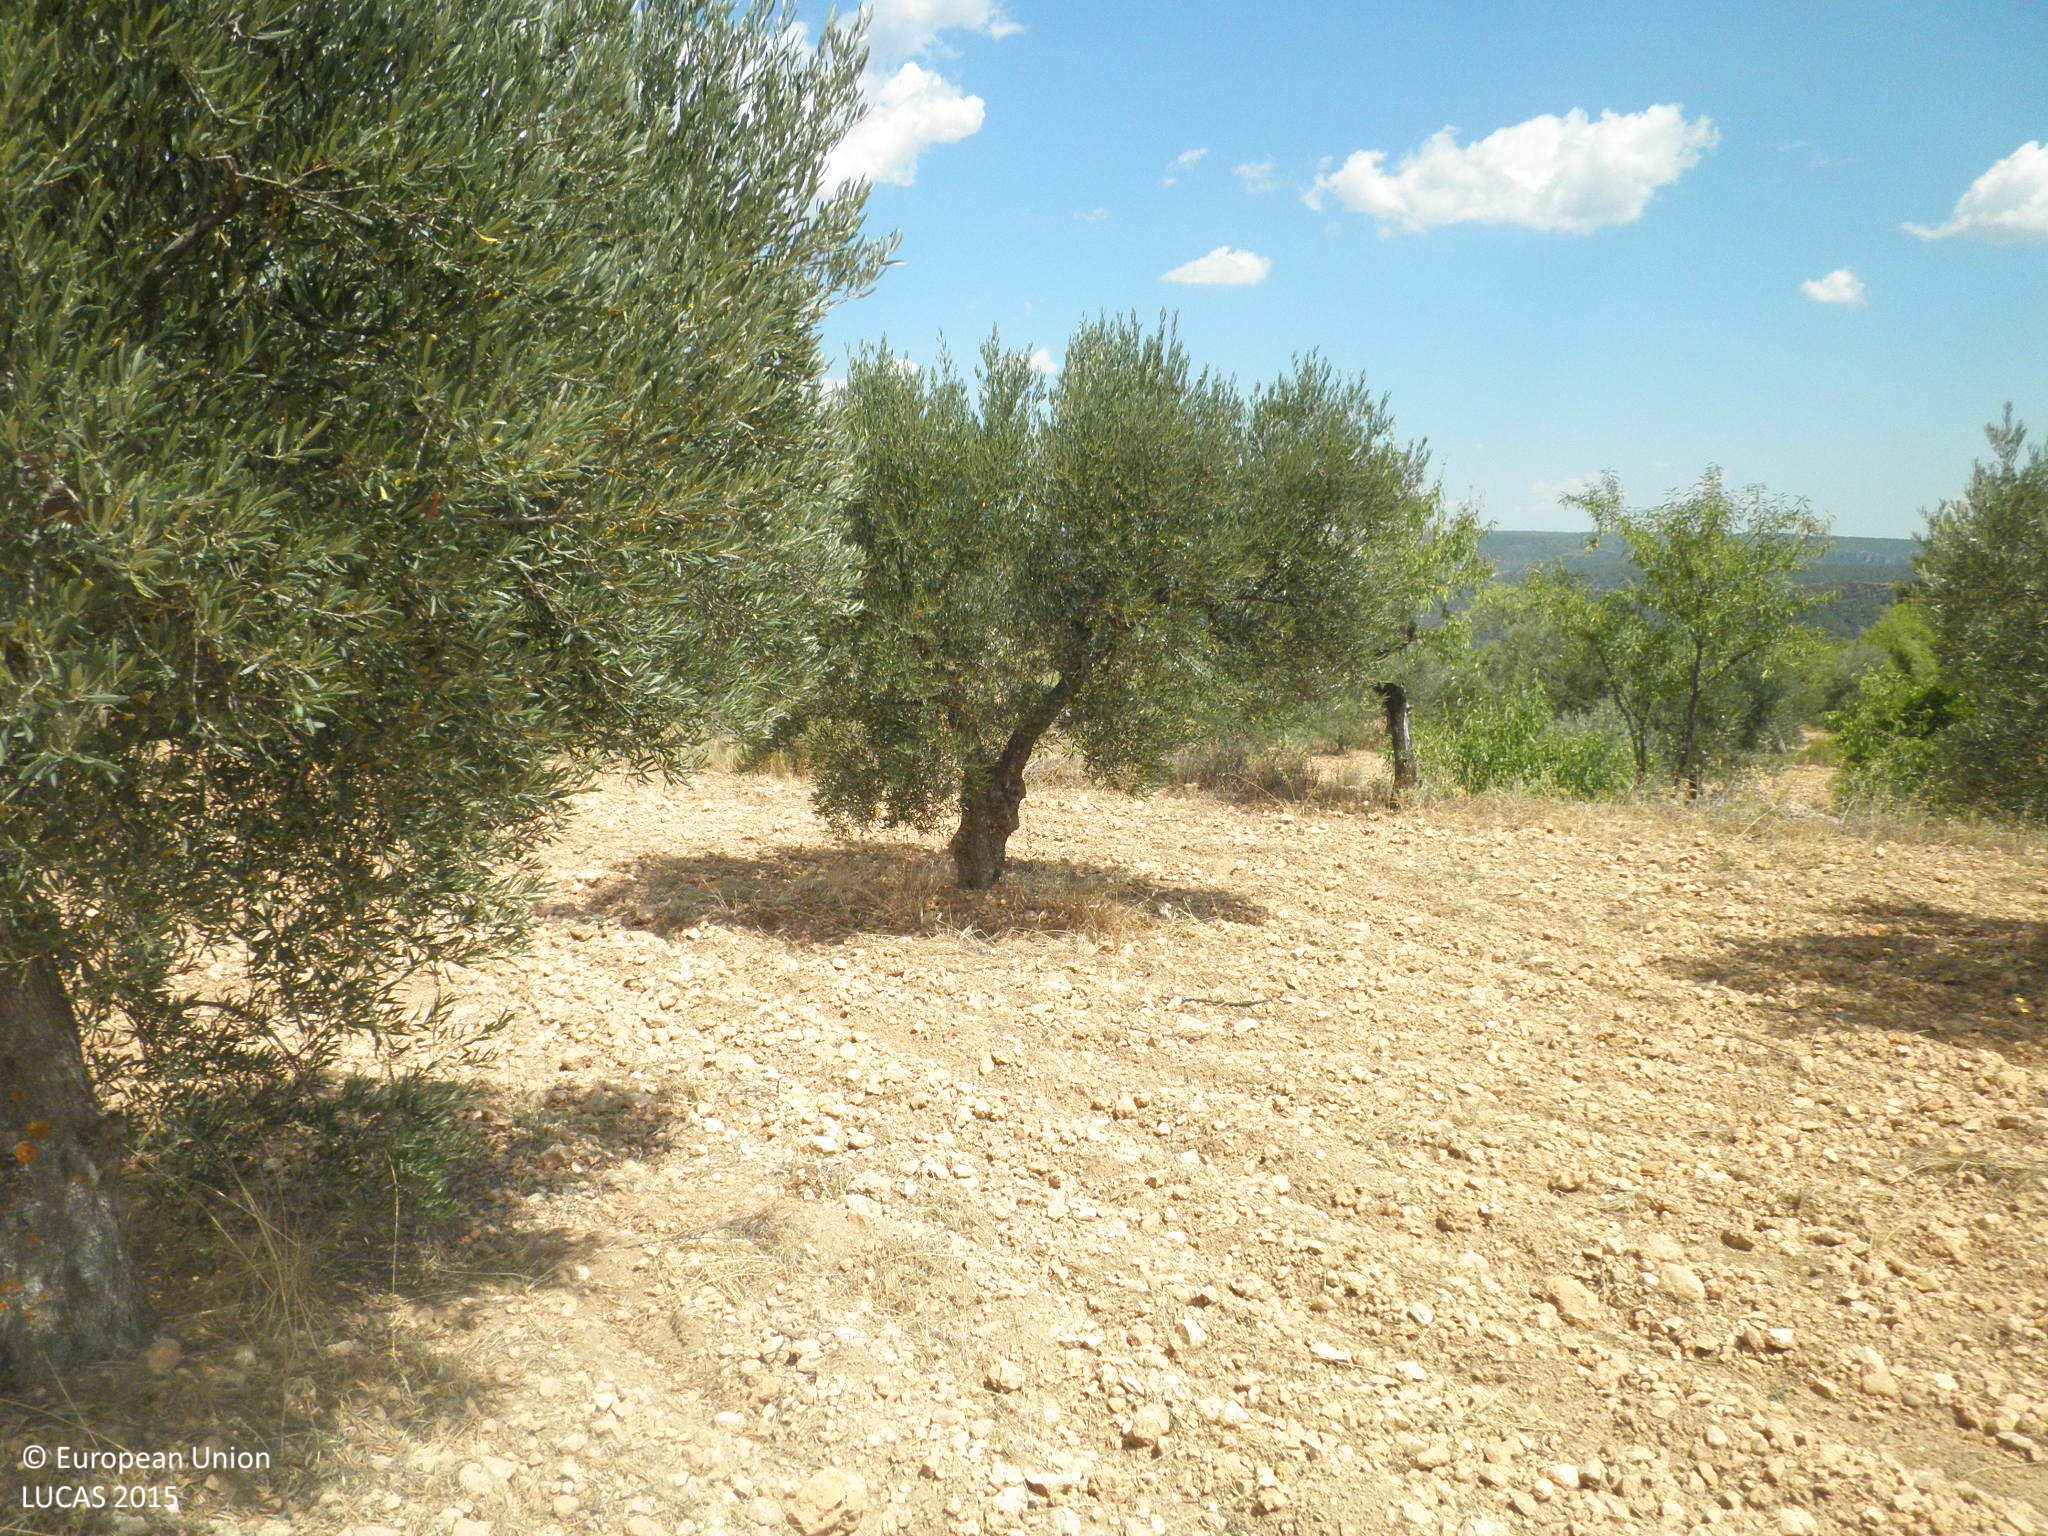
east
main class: Cropland
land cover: Olive groves
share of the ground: 10 - 25 %
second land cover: Other bare soil
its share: > 75 %
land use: Agriculture (excluding fallow land and kitchen gardens)
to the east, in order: Olive groves; Other bare soil; Dry stone walls; Olive groves; Dry stone walls; Shrubland without tree cover; Tracks; Shrubland without tree cover; Tracks; Shrubland with sparse tree cover; Rock outcrops; Shrubland without tree cover
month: July
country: ES
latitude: 39.6675
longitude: -1.6054
